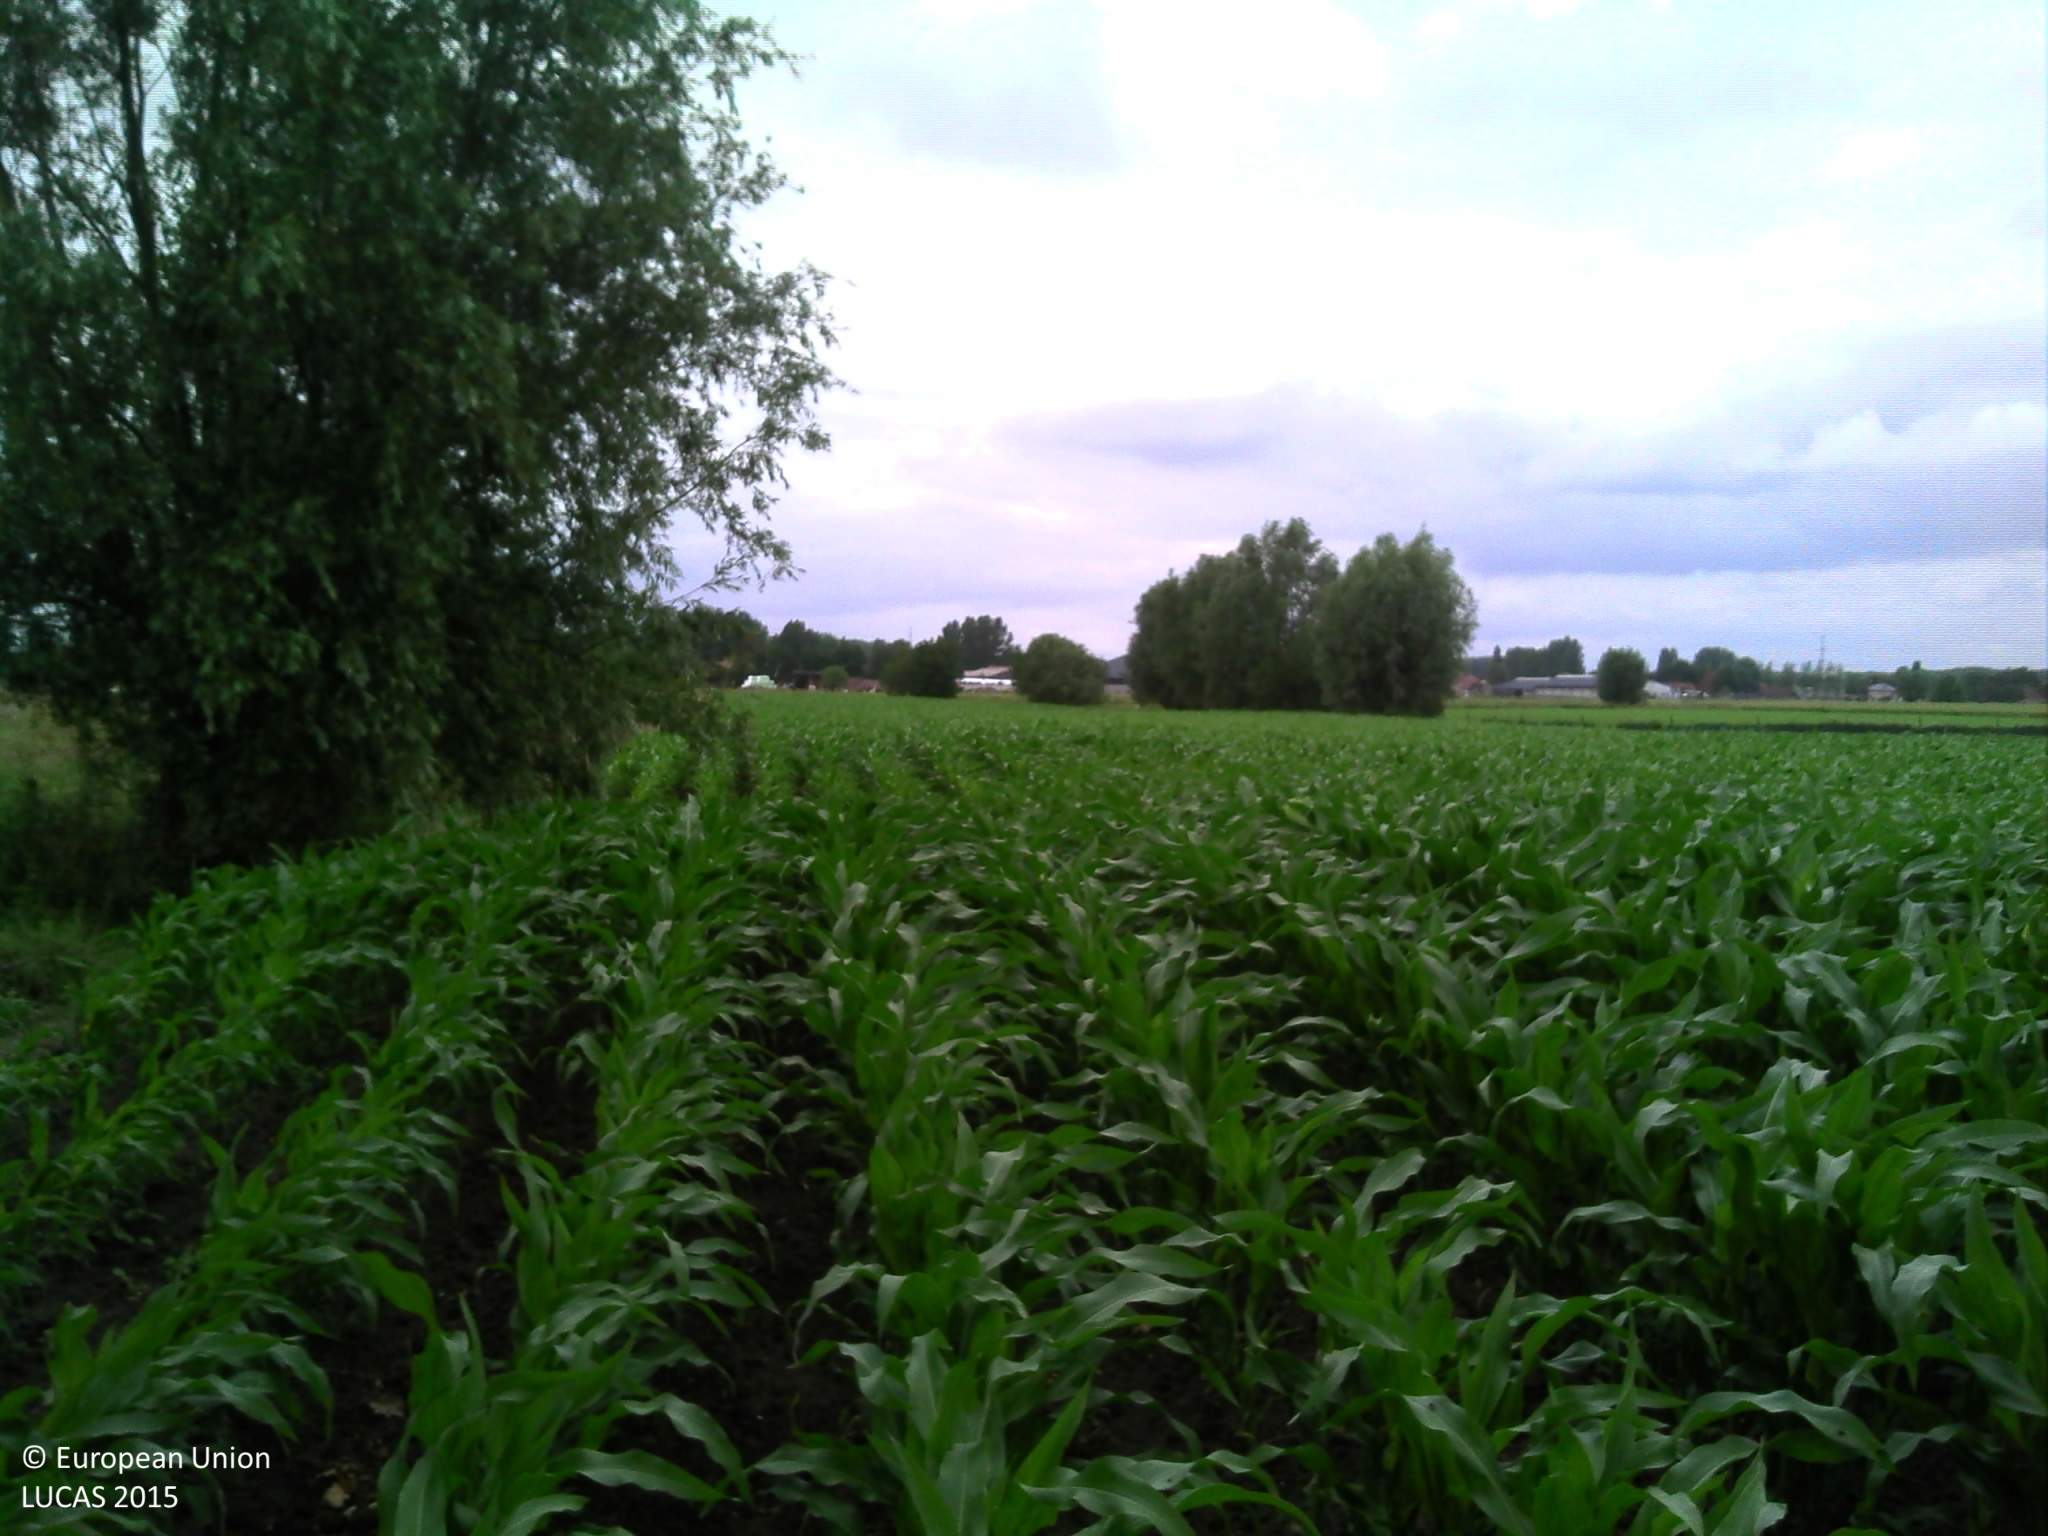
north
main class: Cropland
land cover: Maize
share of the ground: > 75 %
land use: Agriculture (excluding fallow land and kitchen gardens)
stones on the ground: < 10 %
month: June
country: BE
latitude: 51.1205
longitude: 3.8932
